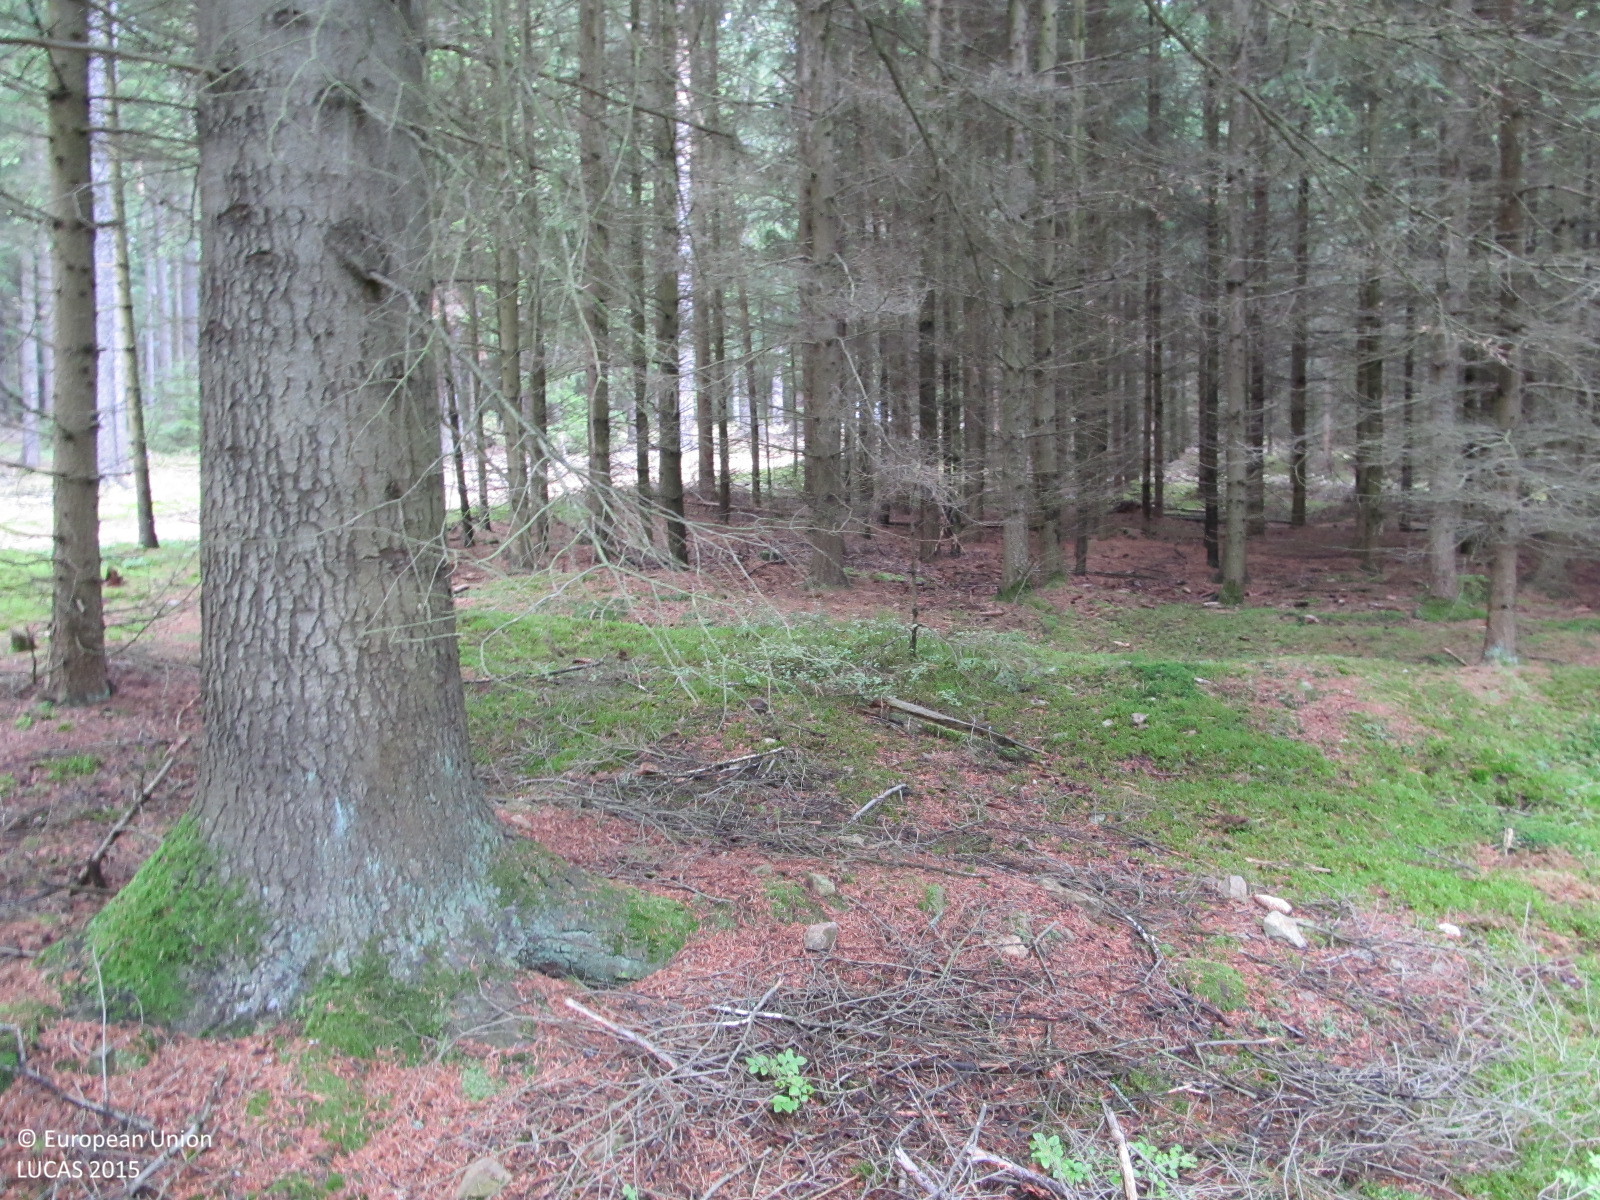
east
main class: Woodland
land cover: Spruce dominated coniferous woodland
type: hemiboreal forest and nemoral coniferous forest and mixed broadleaved-coniferous forest
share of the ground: > 75 %
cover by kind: coniferous forest trees 80 %, herbaceous plants 10 %, lichens and mosses 10 %
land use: Forestry
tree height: > 5 m
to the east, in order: Spruce dominated coniferous woodland; Tracks; Other coniferous woodland; Tracks; Other coniferous woodland; Tracks; Spruce dominated coniferous woodland
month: September
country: AT
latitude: 48.9761
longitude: 15.3723
